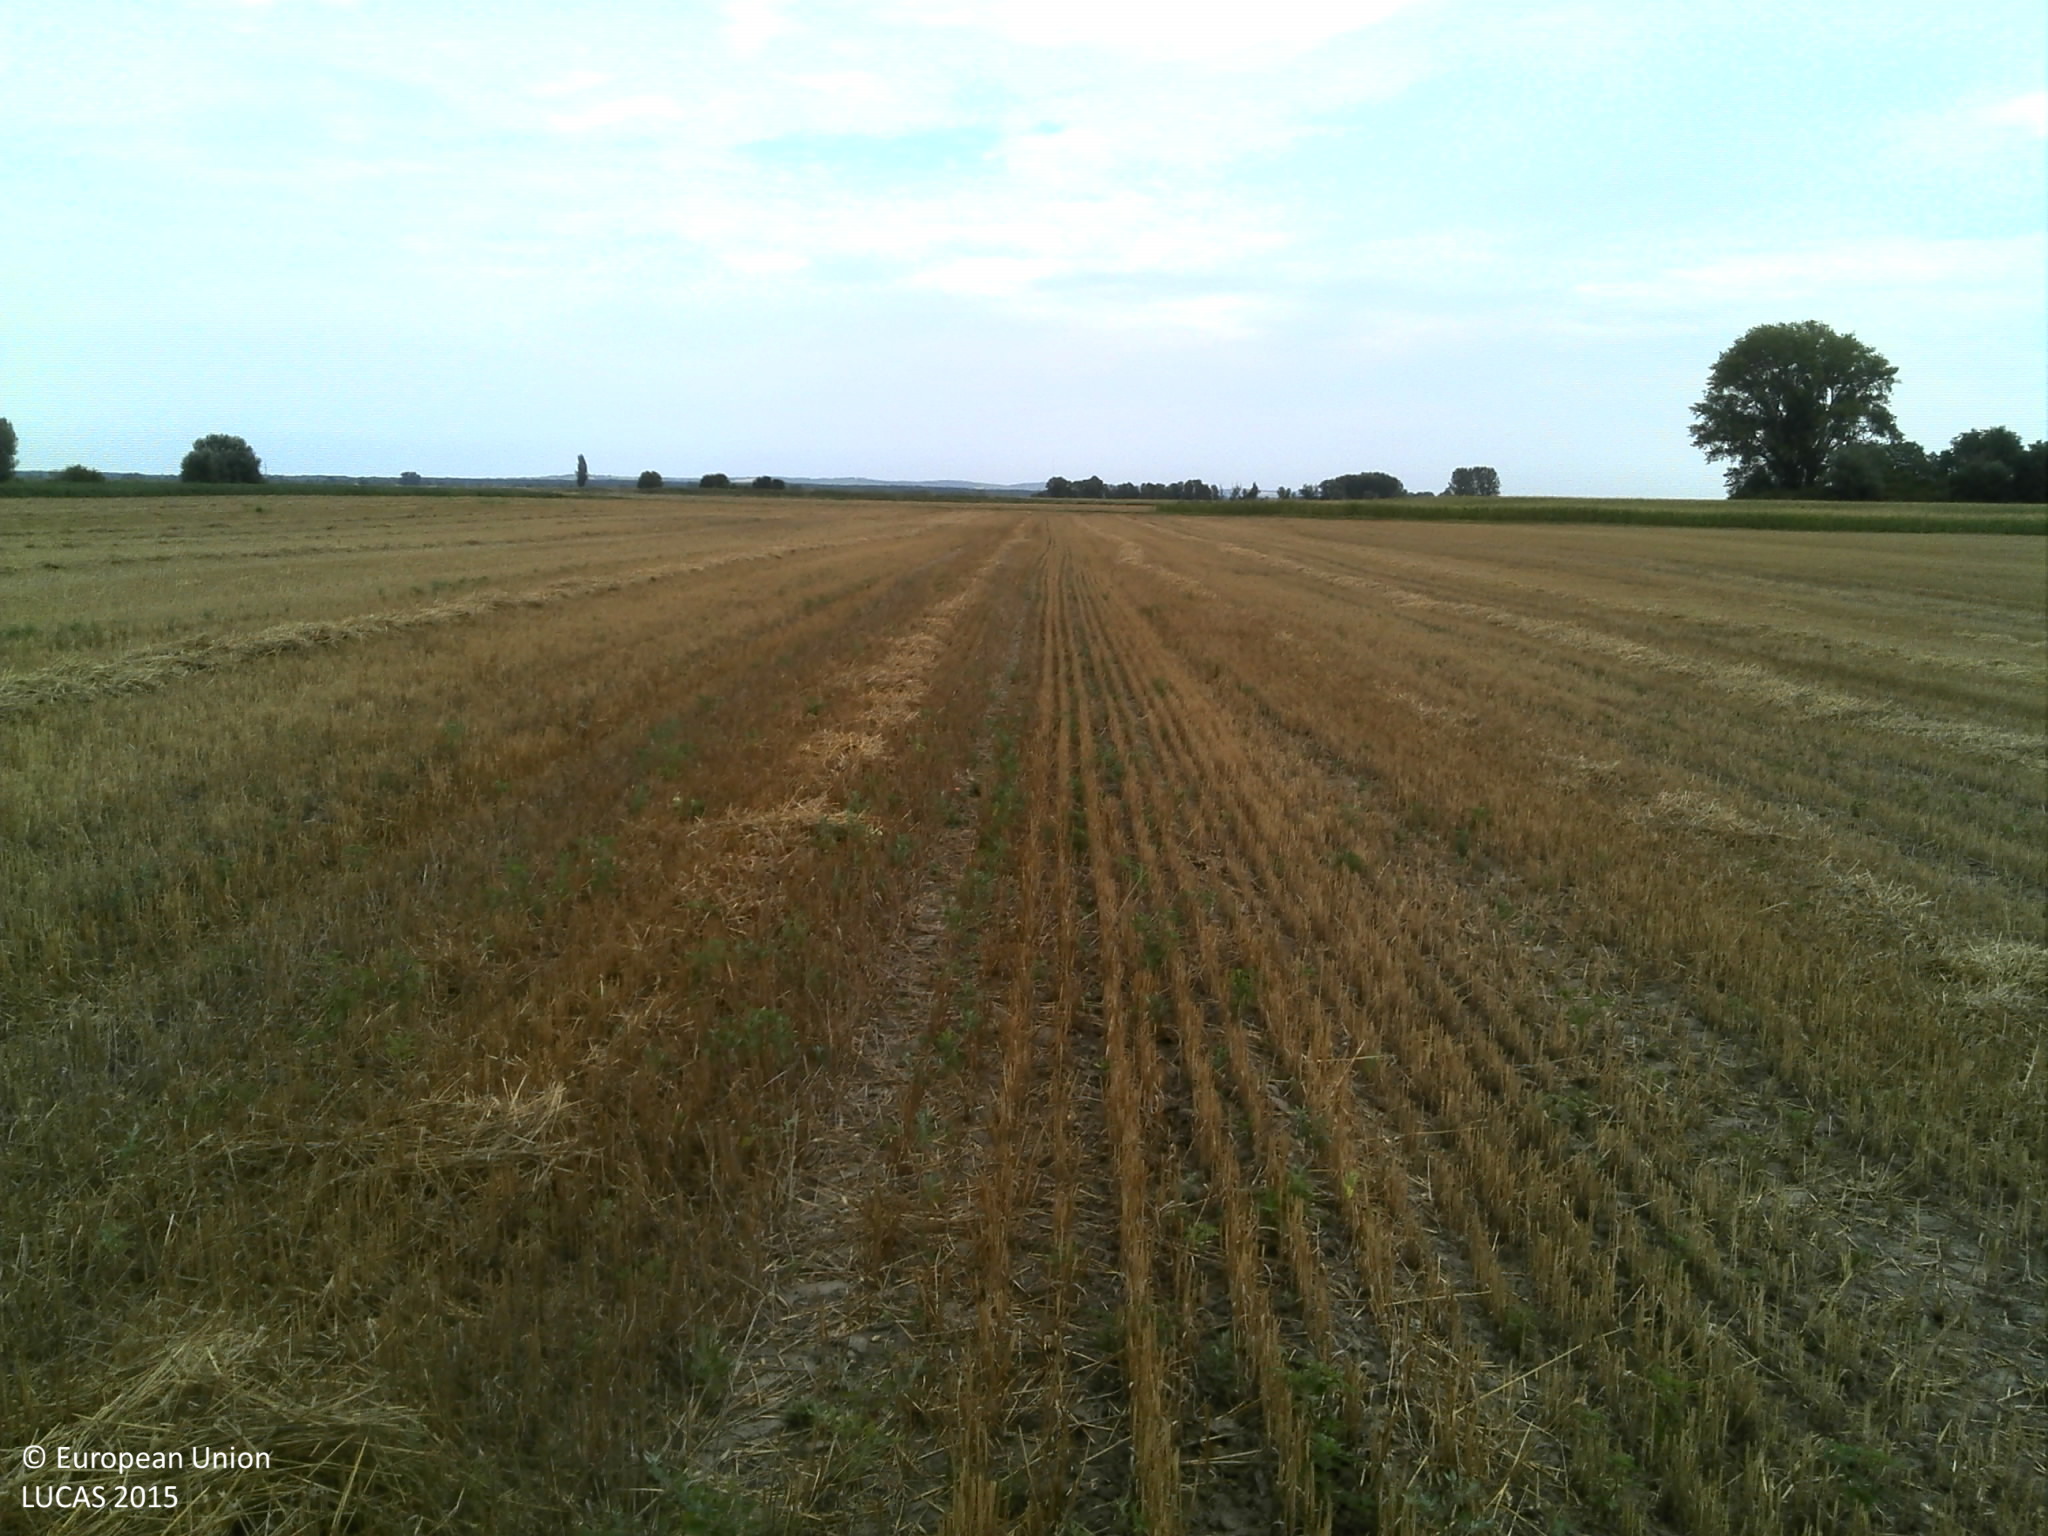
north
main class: Cropland
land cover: Common wheat
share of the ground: > 75 %
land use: Agriculture (excluding fallow land and kitchen gardens)
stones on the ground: < 10 %
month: July
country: HR
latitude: 45.6607
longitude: 18.5937
